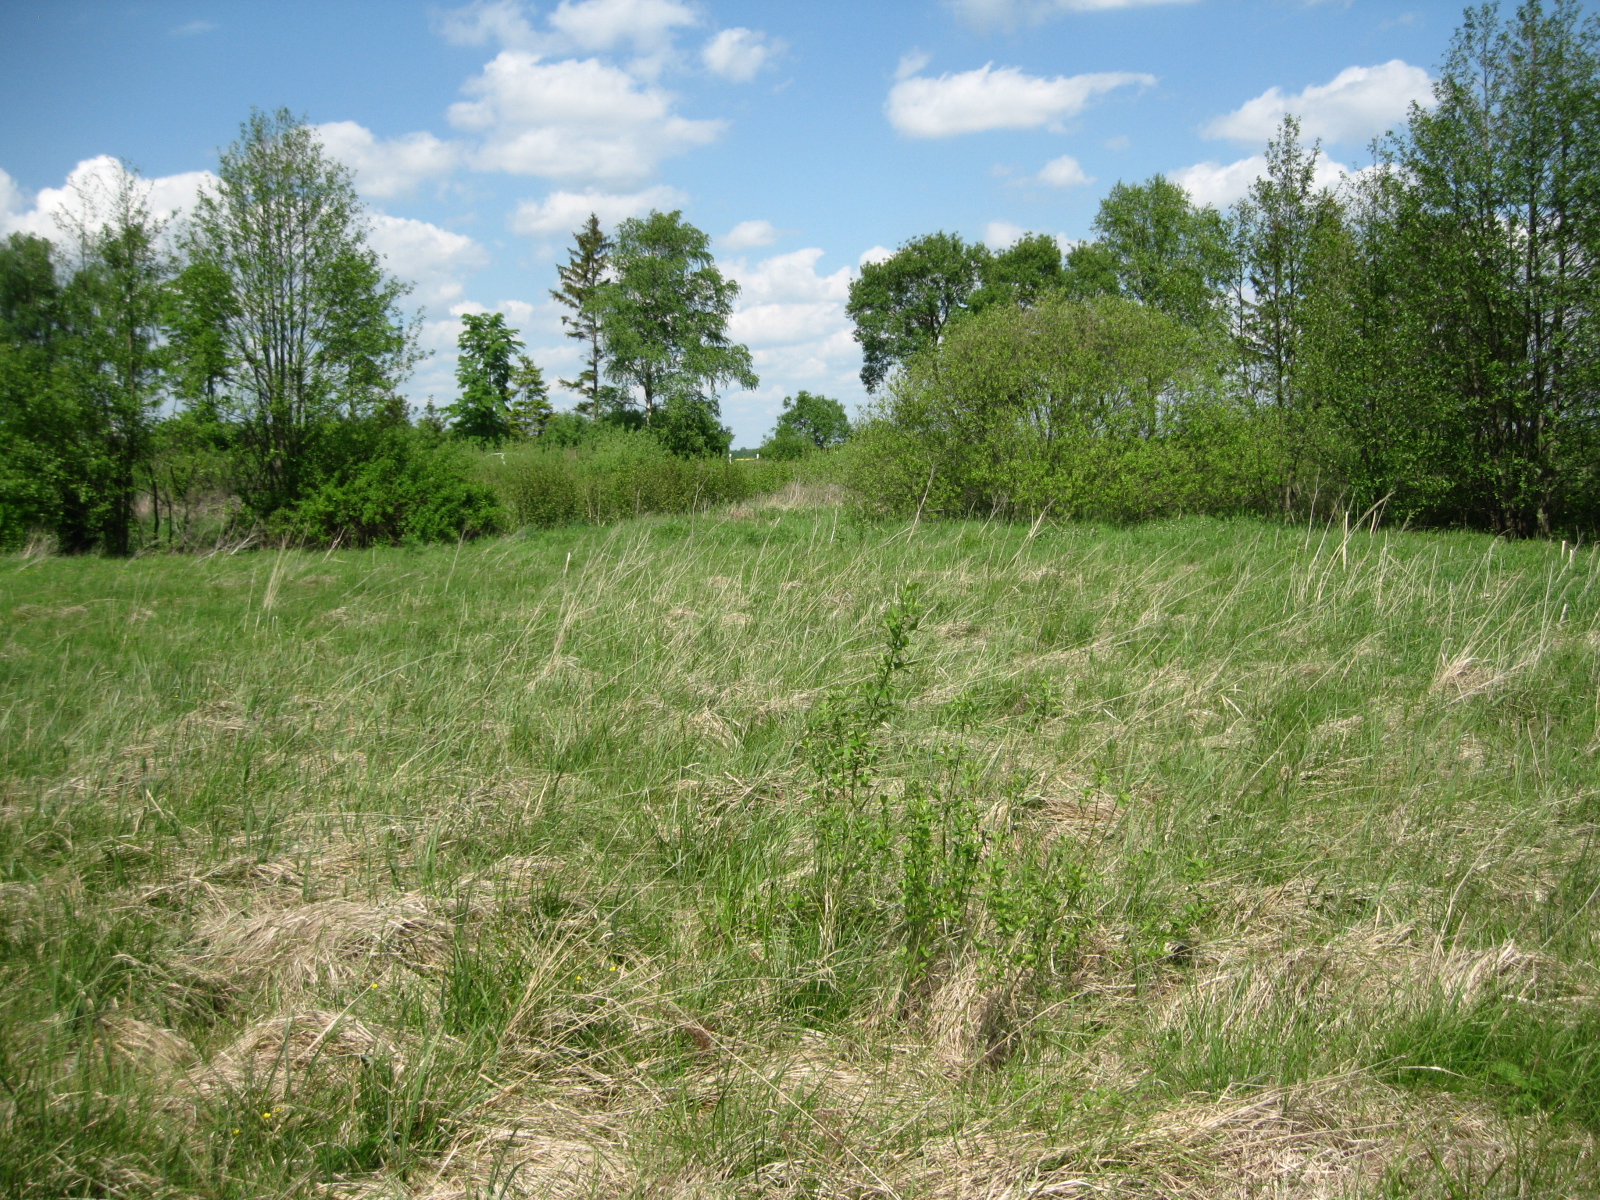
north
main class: Grassland
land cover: Grassland without tree/shrub cover
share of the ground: > 75 %
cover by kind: herbaceous plants 100 %
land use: Agriculture (excluding fallow land and kitchen gardens)
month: May
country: LT
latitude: 56.0399
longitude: 24.1348
